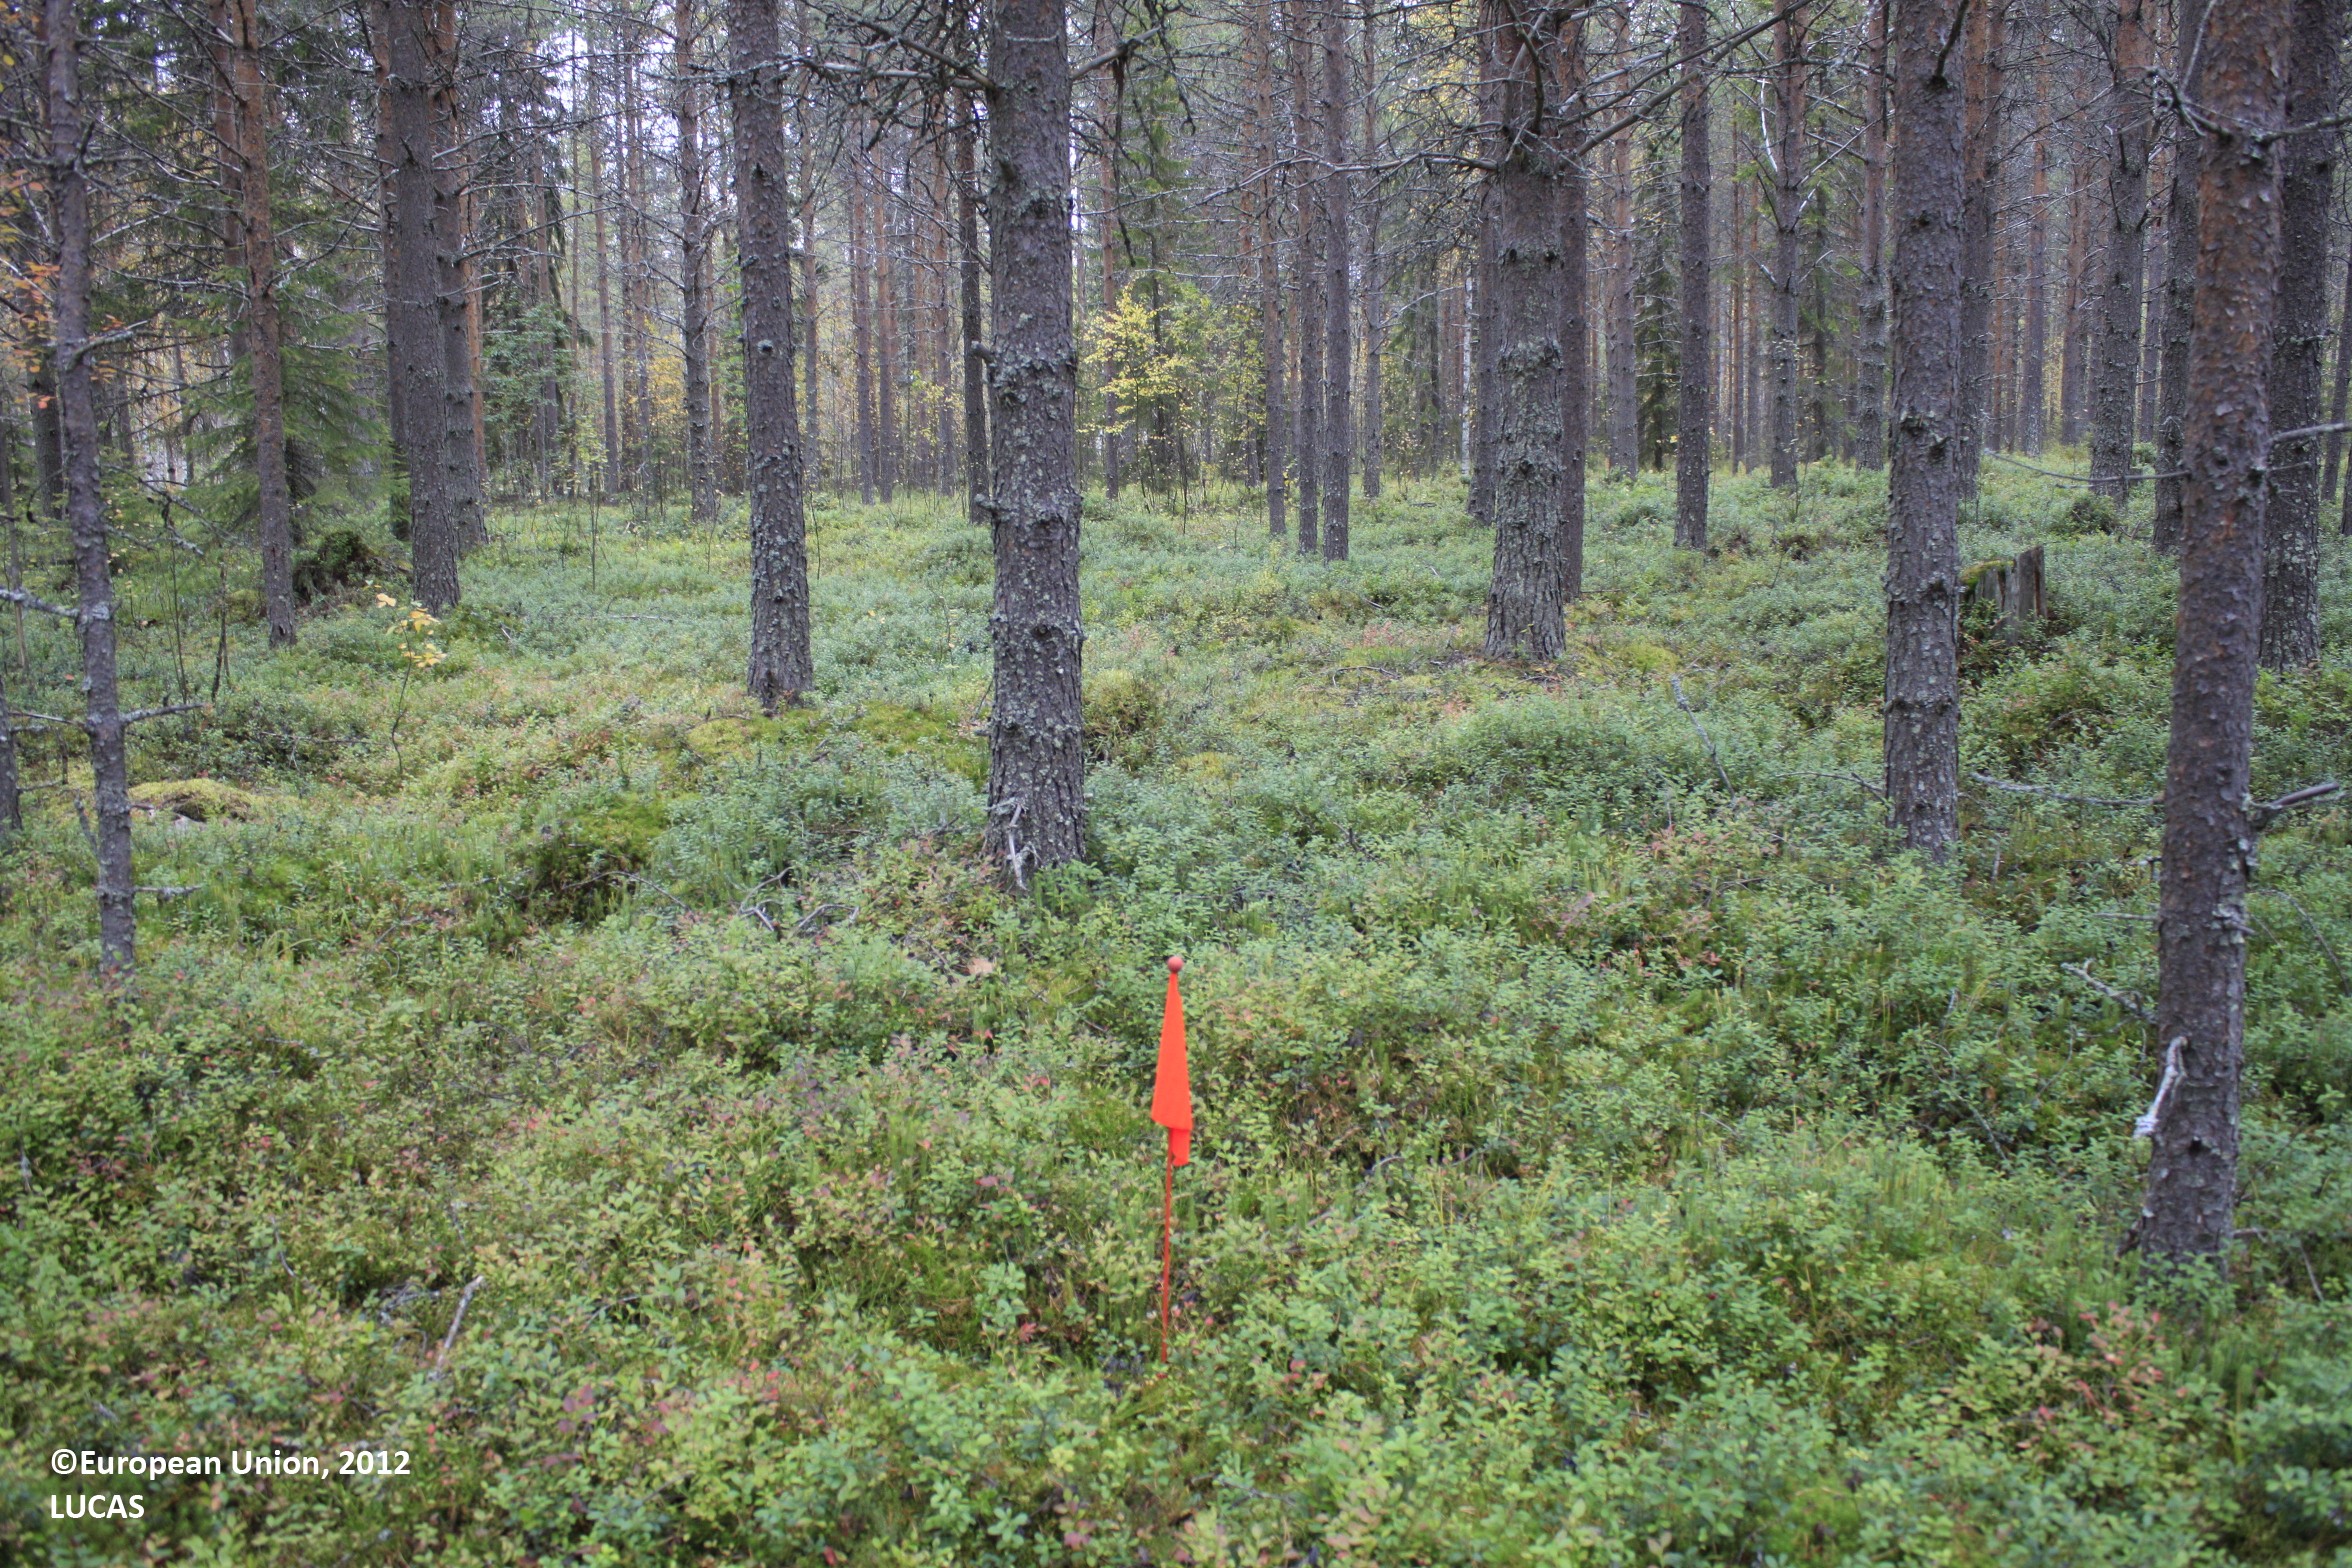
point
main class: Woodland
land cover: Pine dominated coniferous woodland
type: boreal forest
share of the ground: 50 - 75 %
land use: Forestry
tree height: > 5 m
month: September
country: FI
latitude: 65.5451
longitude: 27.2451
